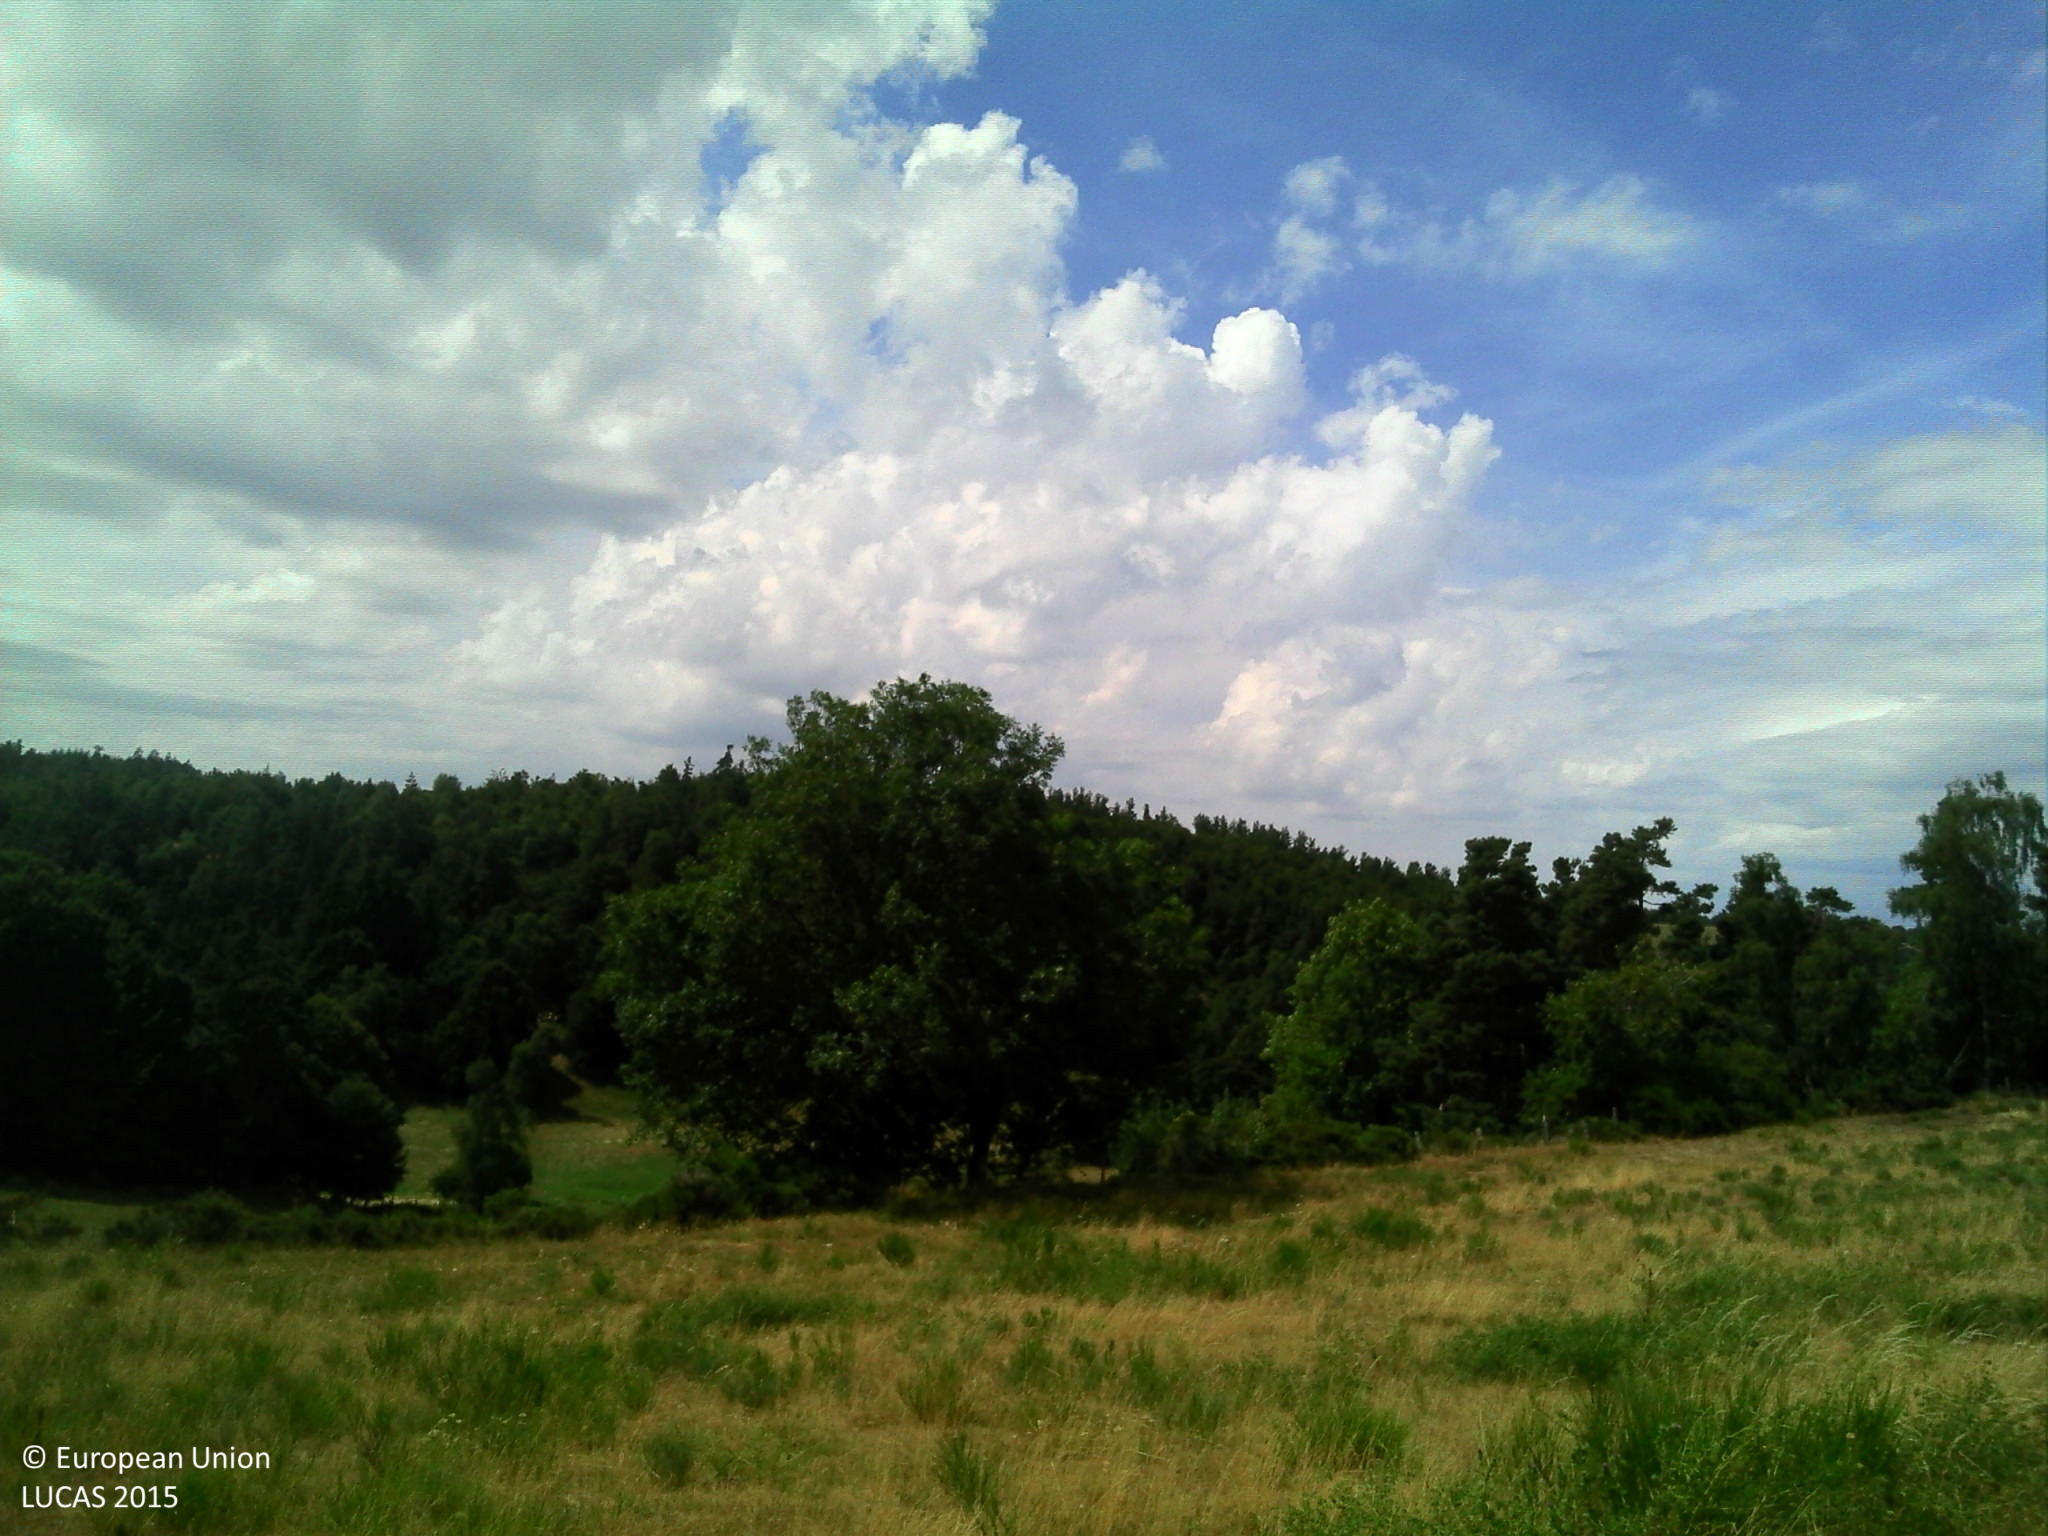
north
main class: Grassland
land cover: Grassland with sparse tree/shrub cover
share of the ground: > 75 %
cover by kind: herbaceous plants 85 %, shrubs 10 %, coniferous forest trees 5 %
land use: Agriculture (excluding fallow land and kitchen gardens)
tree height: < 5 m
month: July
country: FR
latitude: 44.6901
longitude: 3.2280
